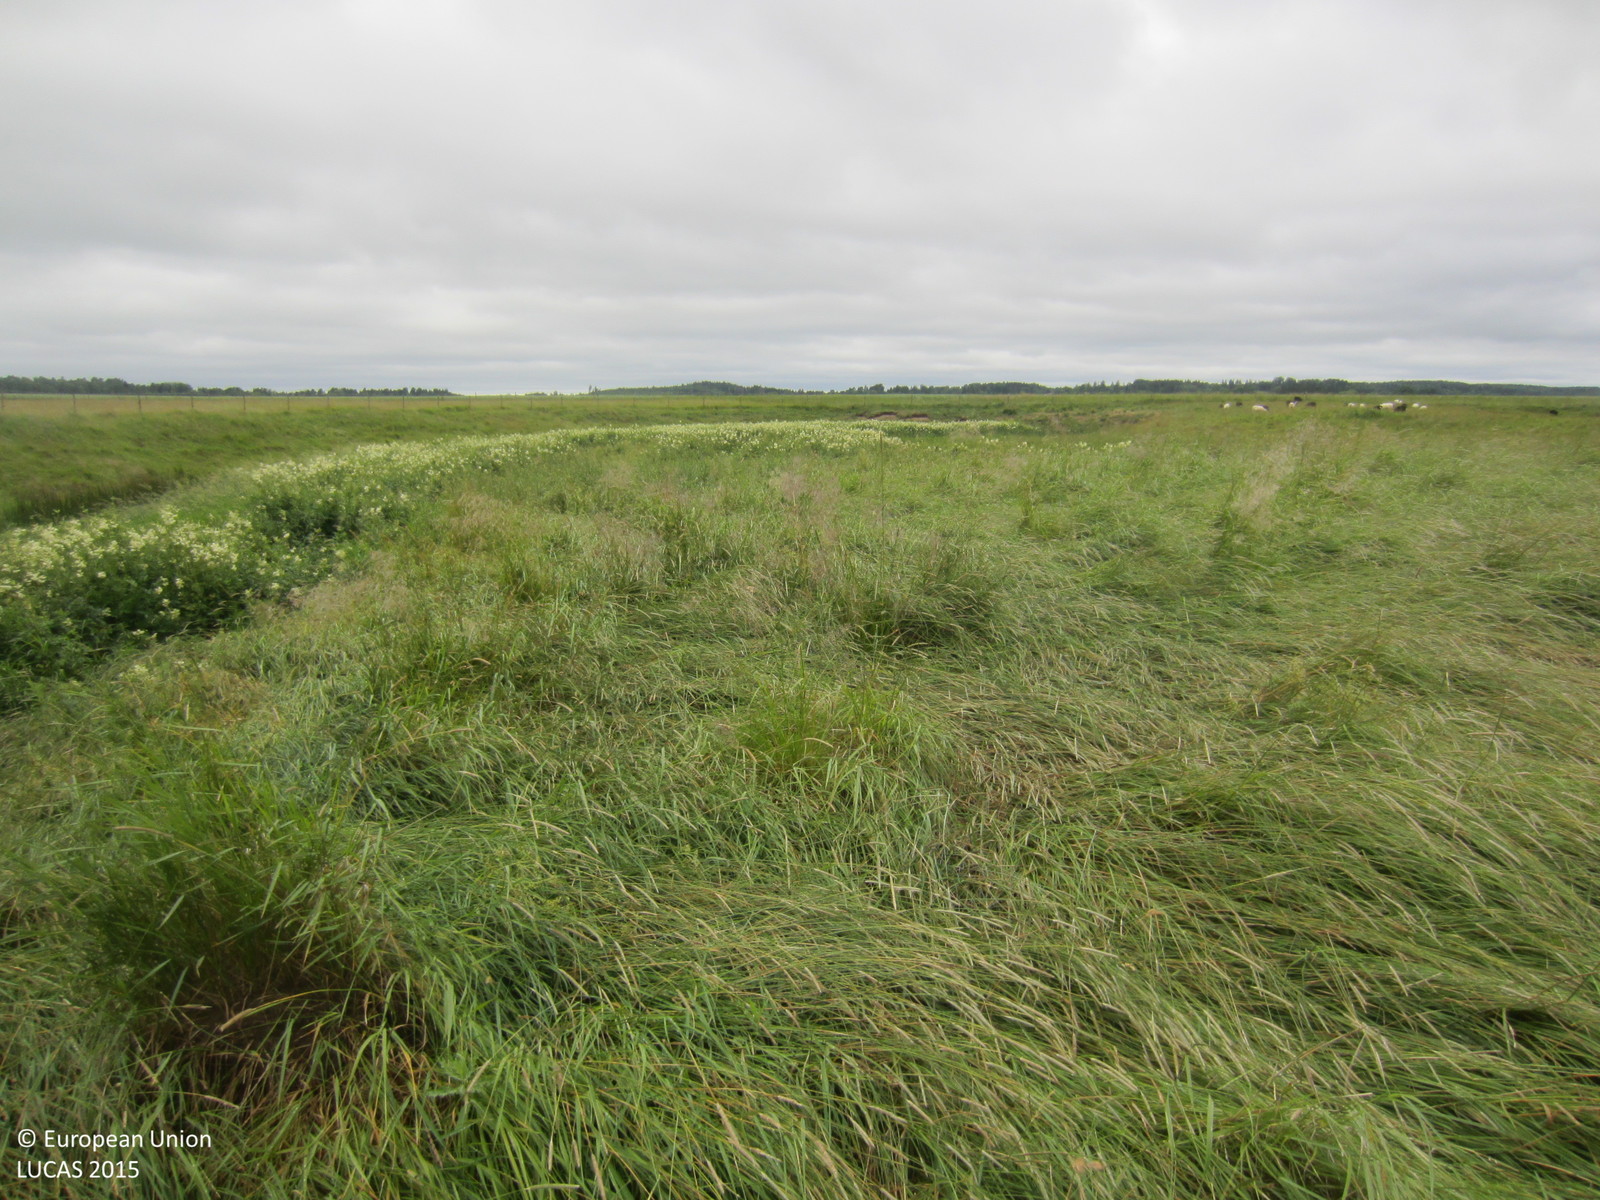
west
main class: Grassland
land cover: Grassland without tree/shrub cover
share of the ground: > 75 %
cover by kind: herbaceous plants 100 %
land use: Agriculture (excluding fallow land and kitchen gardens)
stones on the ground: > 50 %
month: July
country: SE
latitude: 59.7687
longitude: 17.0618
